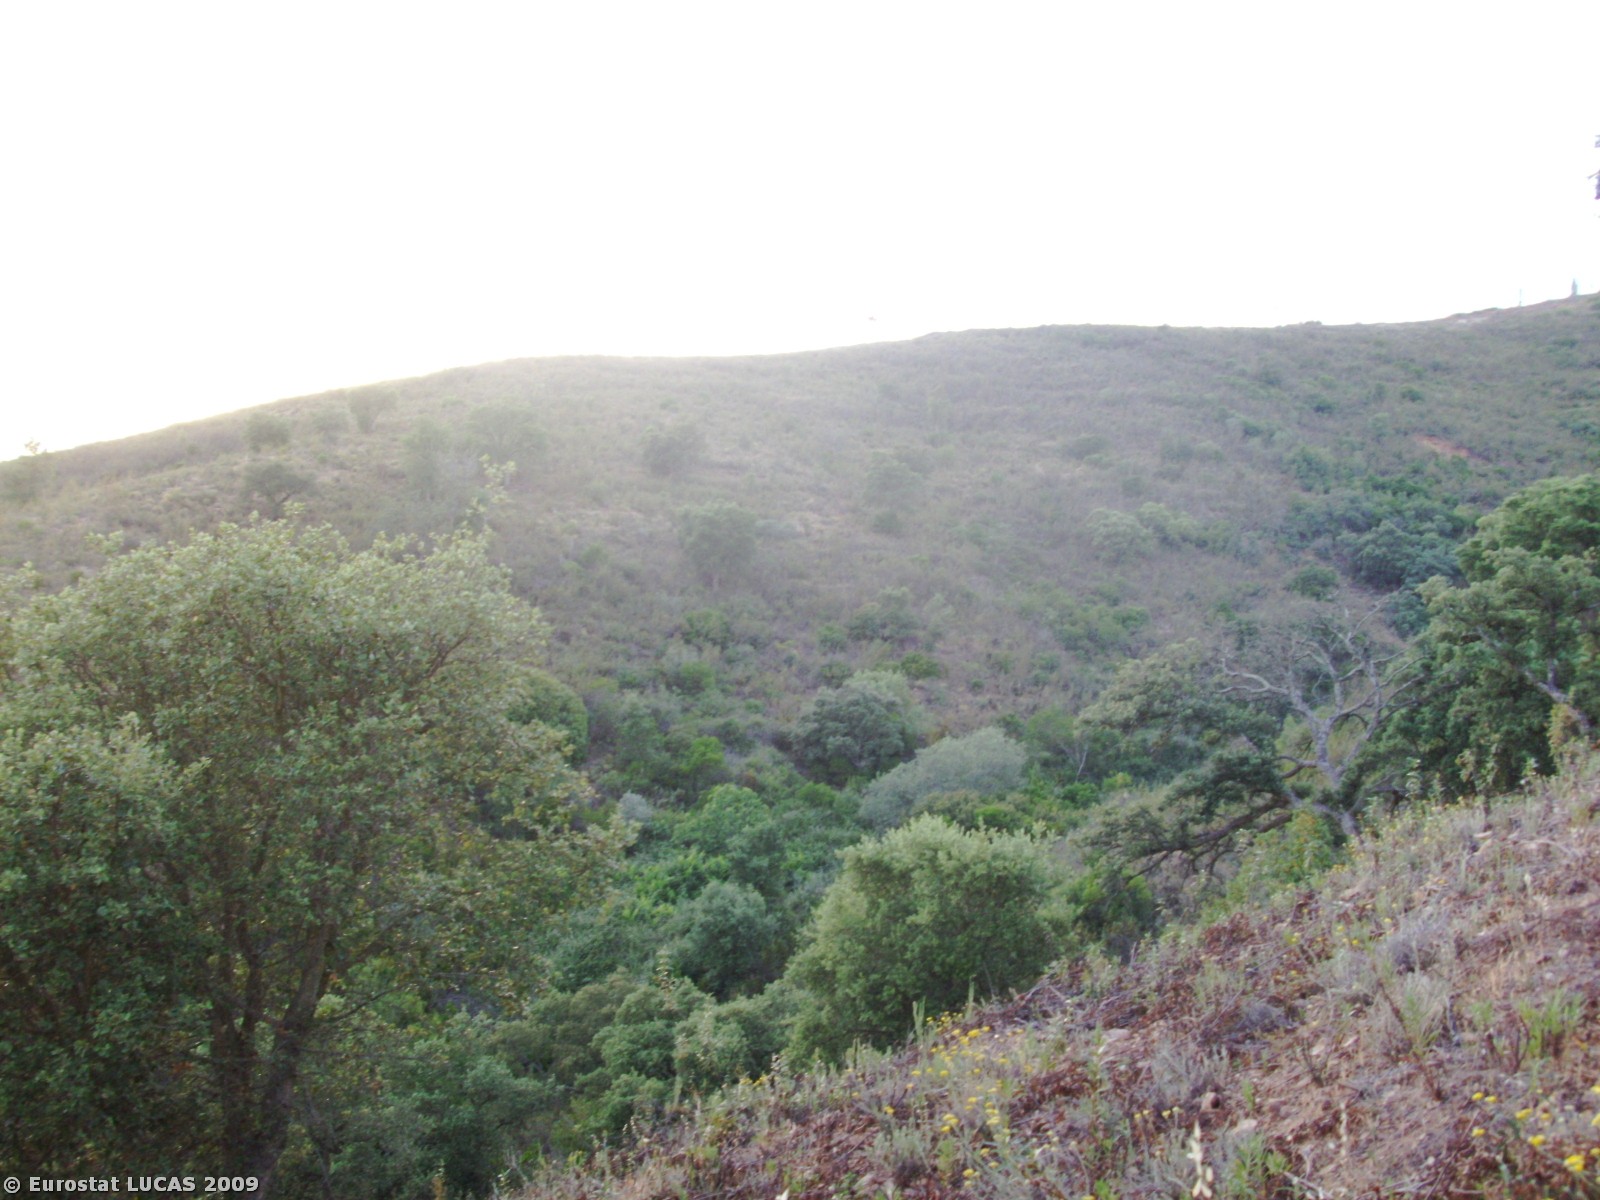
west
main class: Woodland
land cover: Broadleaved woodland
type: broadleaved evergreen forest
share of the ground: 10 - 25 %
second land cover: Spontaneously vegetated surfaces
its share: 50 - 75 %
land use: Forestry
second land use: Fallow land
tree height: > 5 m
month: May
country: PT
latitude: 37.3976
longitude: -8.3141
